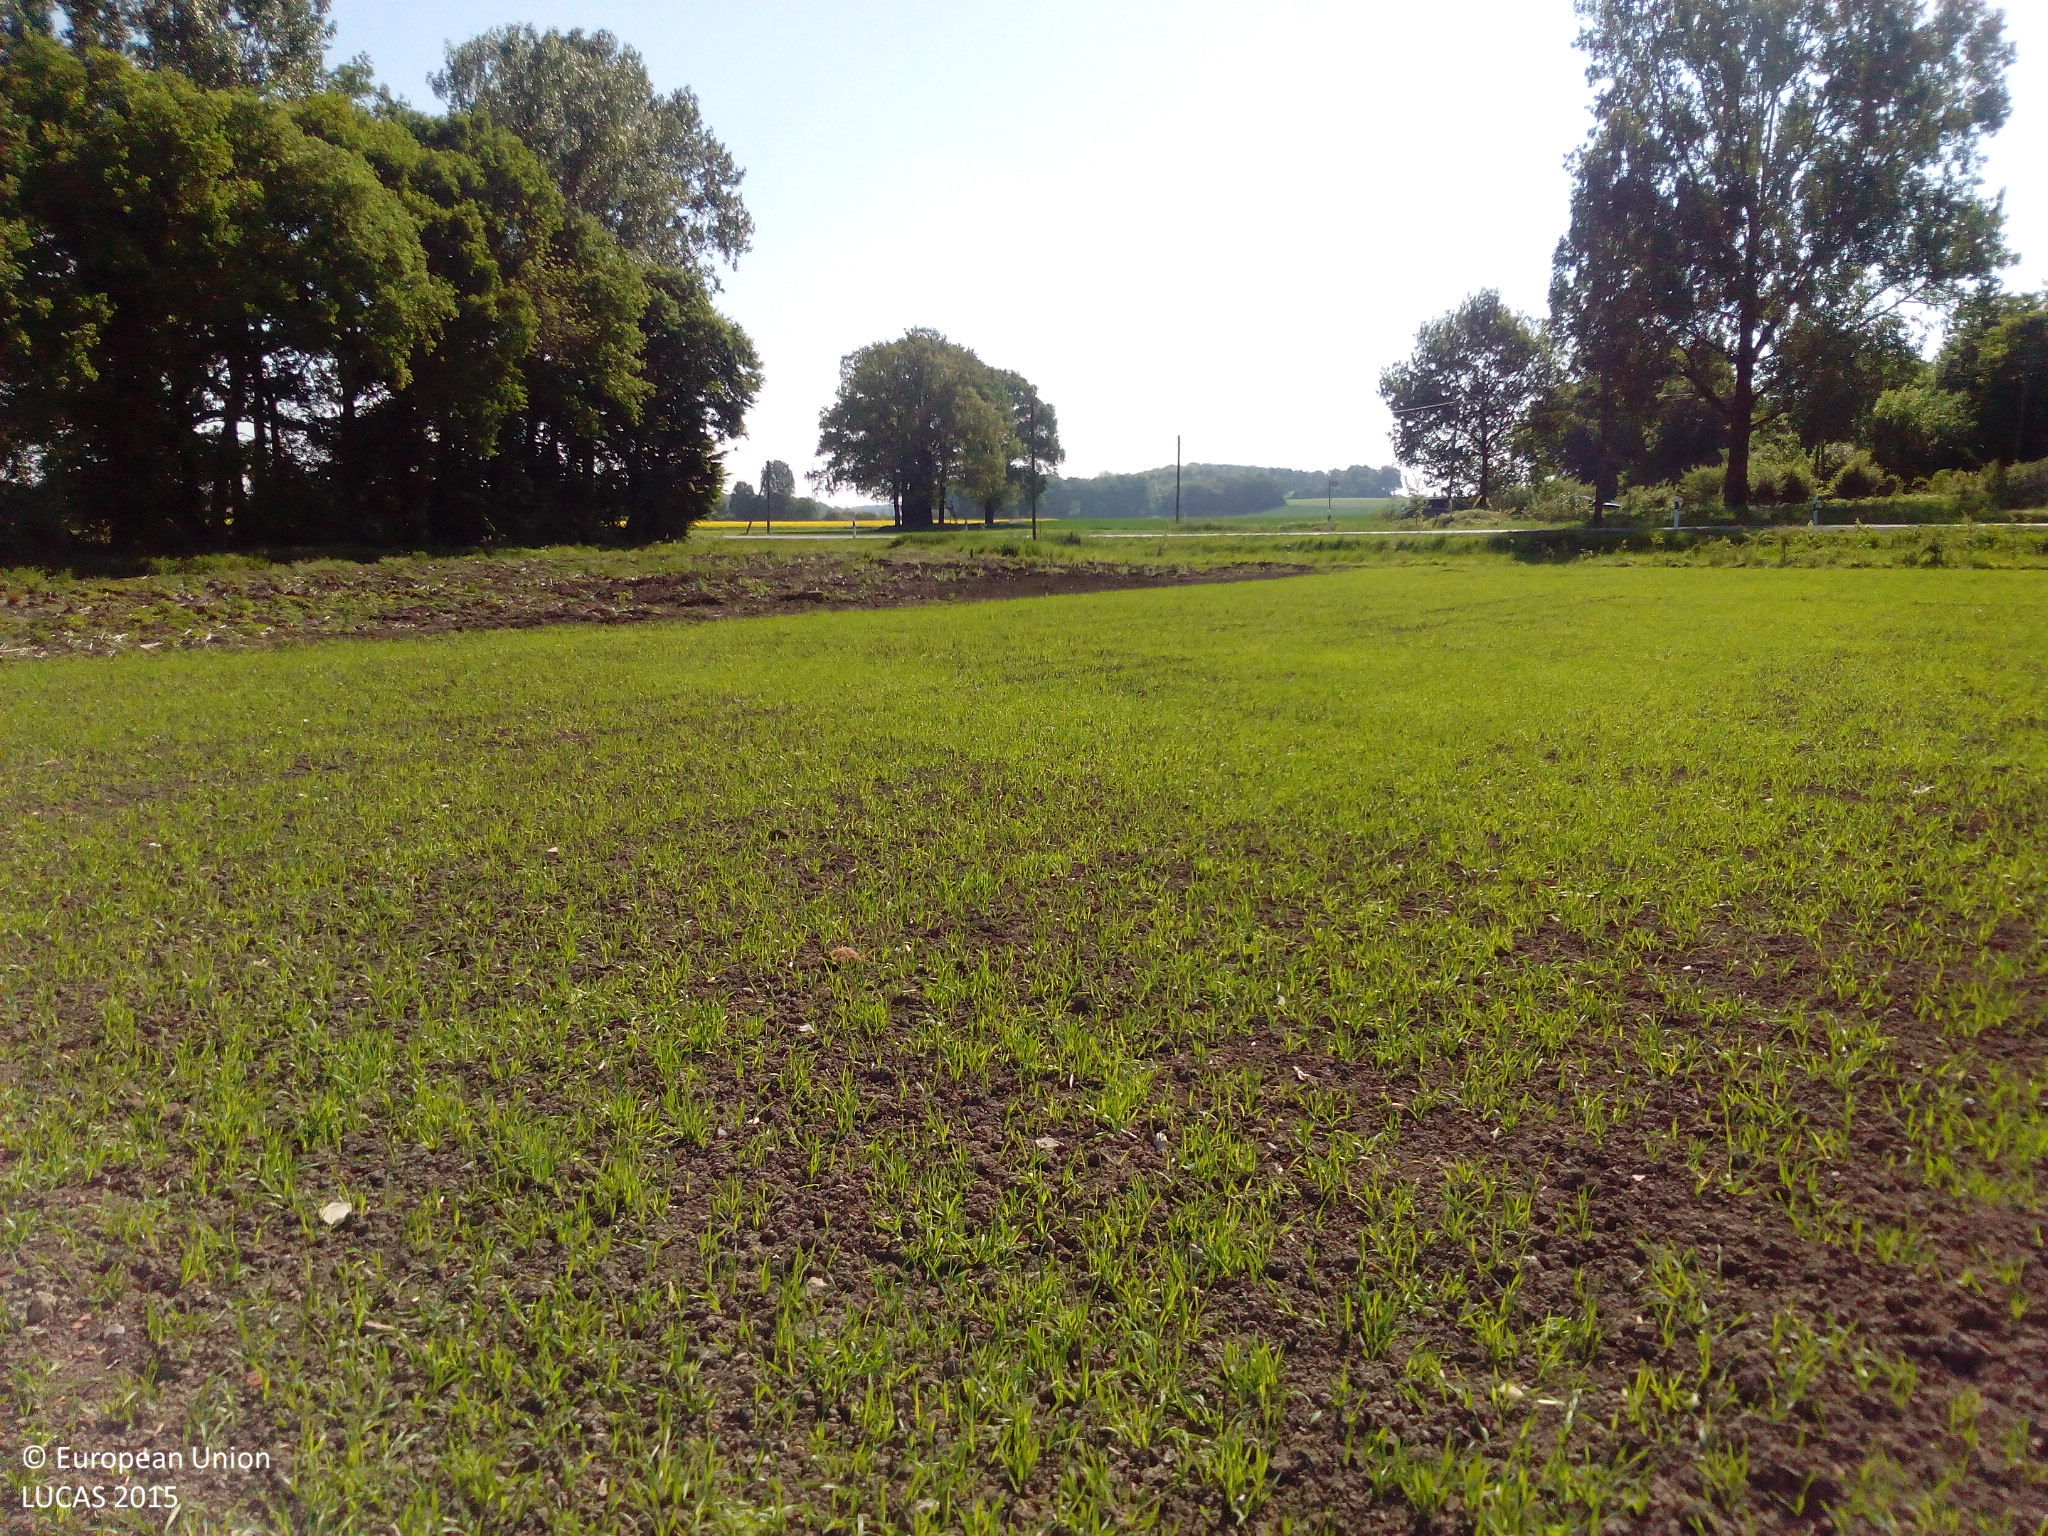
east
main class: Cropland
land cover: Common wheat
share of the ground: 25 - 50 %
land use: Agriculture (excluding fallow land and kitchen gardens)
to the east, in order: Common wheat; Shruby margins; Ditches and canals; Grass margins; Paved roads, cycling and walking lanes; Grass margins; Ditches and canals; Shruby margins; Common wheat; Electric lines; Common wheat; Barley; Broadleaved woodland
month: May
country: DE
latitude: 51.8749
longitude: 7.9814
